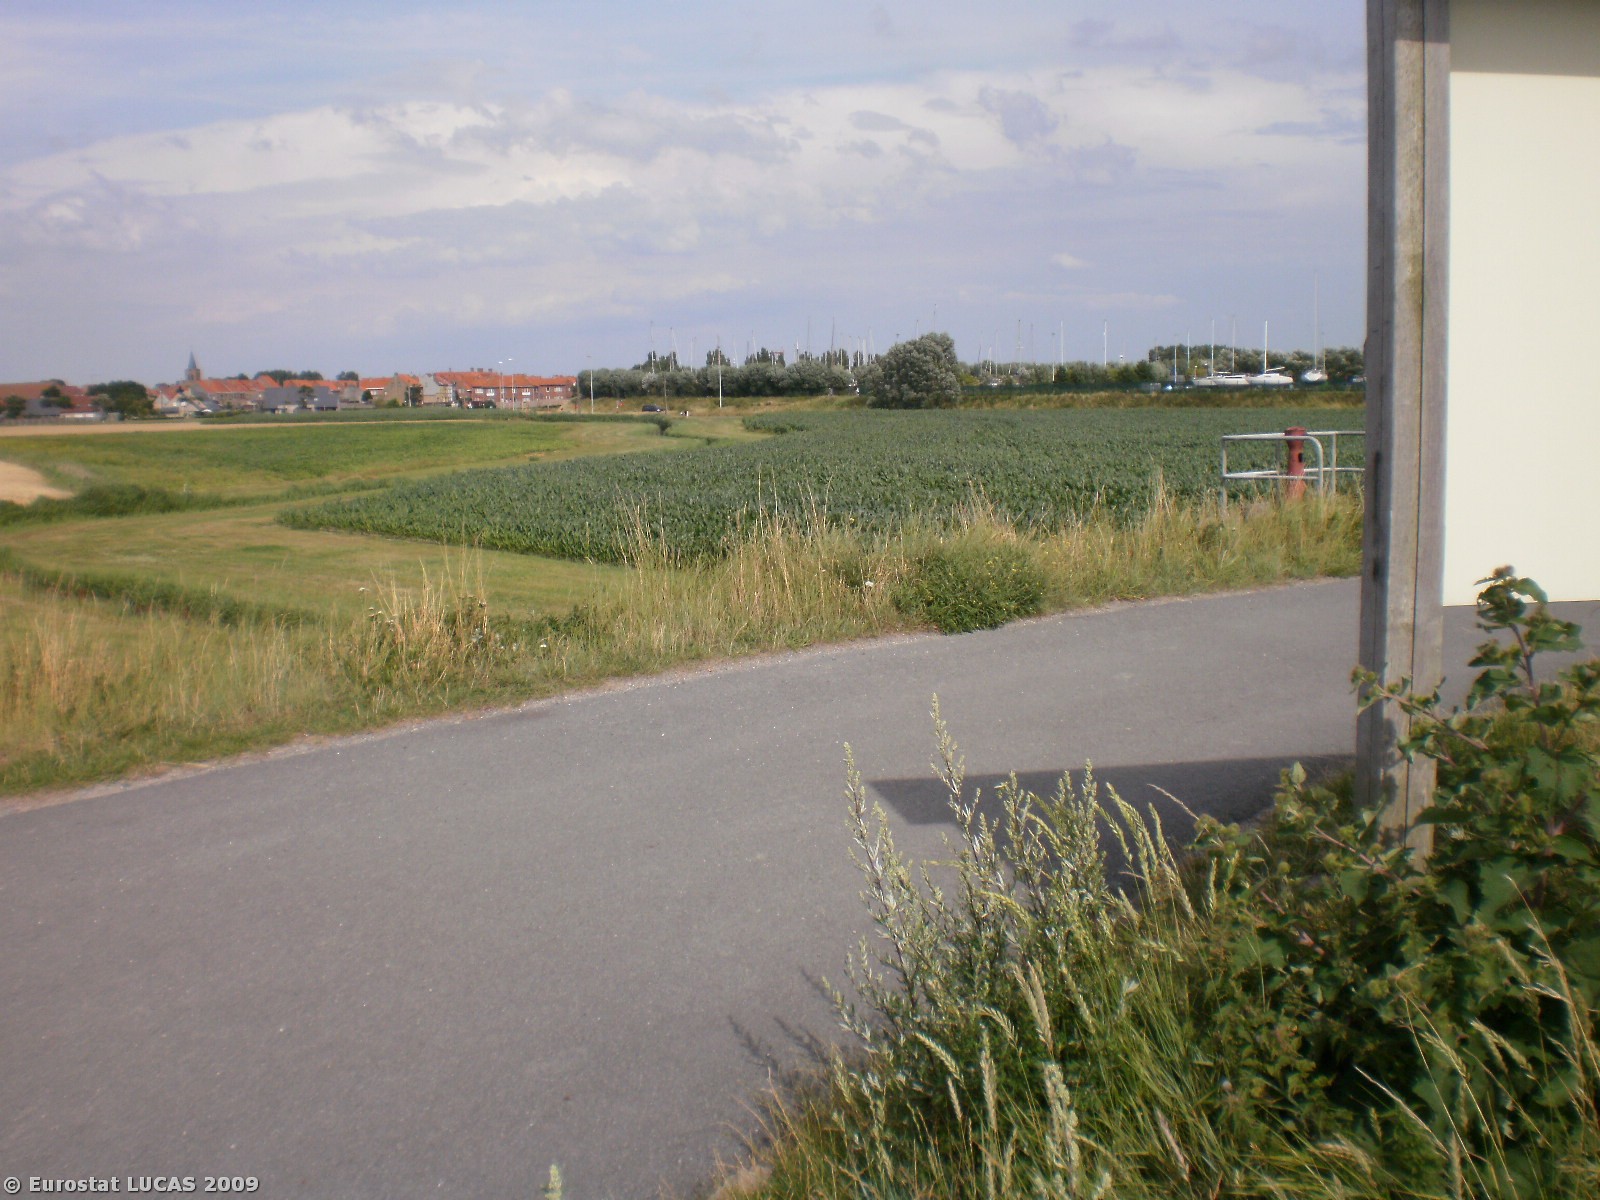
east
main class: Wetlands
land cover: Intertidal flats
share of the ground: > 75 %
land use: Nature reserves
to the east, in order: Intertidal flats; Grassland without tree/shrub cover
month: July
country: BE
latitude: 51.1443
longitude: 2.7414
